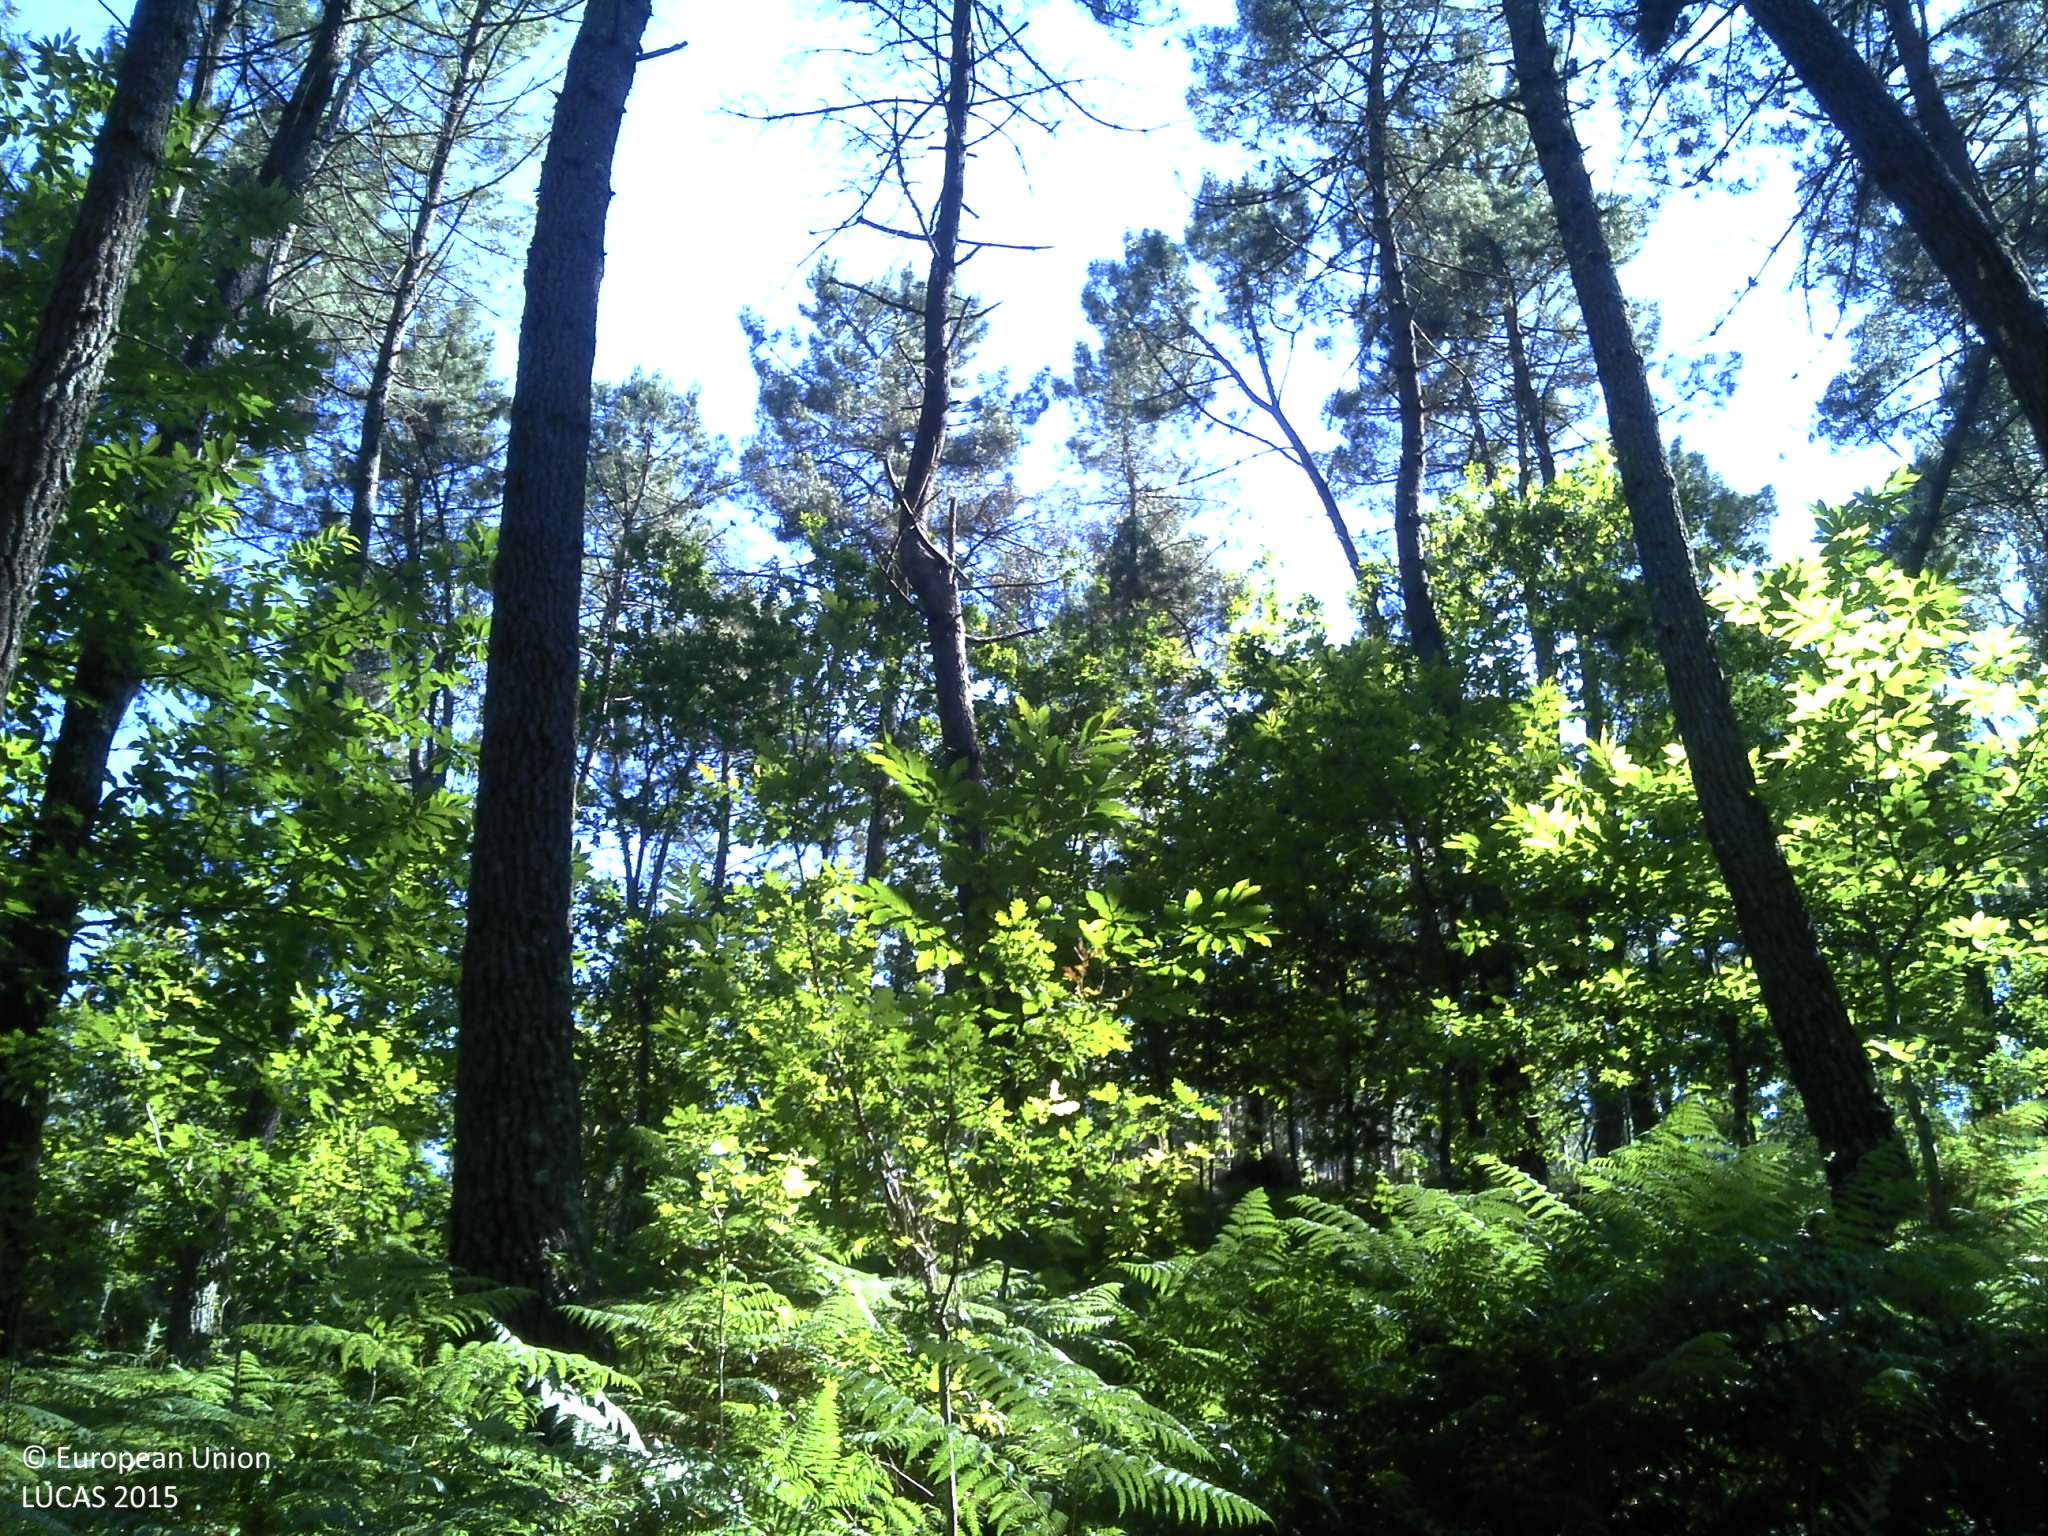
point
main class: Woodland
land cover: Pine dominated mixed woodland
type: coniferous forest of the mediterranean region
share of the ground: 50 - 75 %
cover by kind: coniferous forest trees 50 %, broadleaved forest trees 25 %, shrubs 10 %, herbaceous plants 10 %, unconsolidated bare surface 5 %
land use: Forestry
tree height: > 5 m
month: June
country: PT
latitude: 40.7400
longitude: -8.0465
